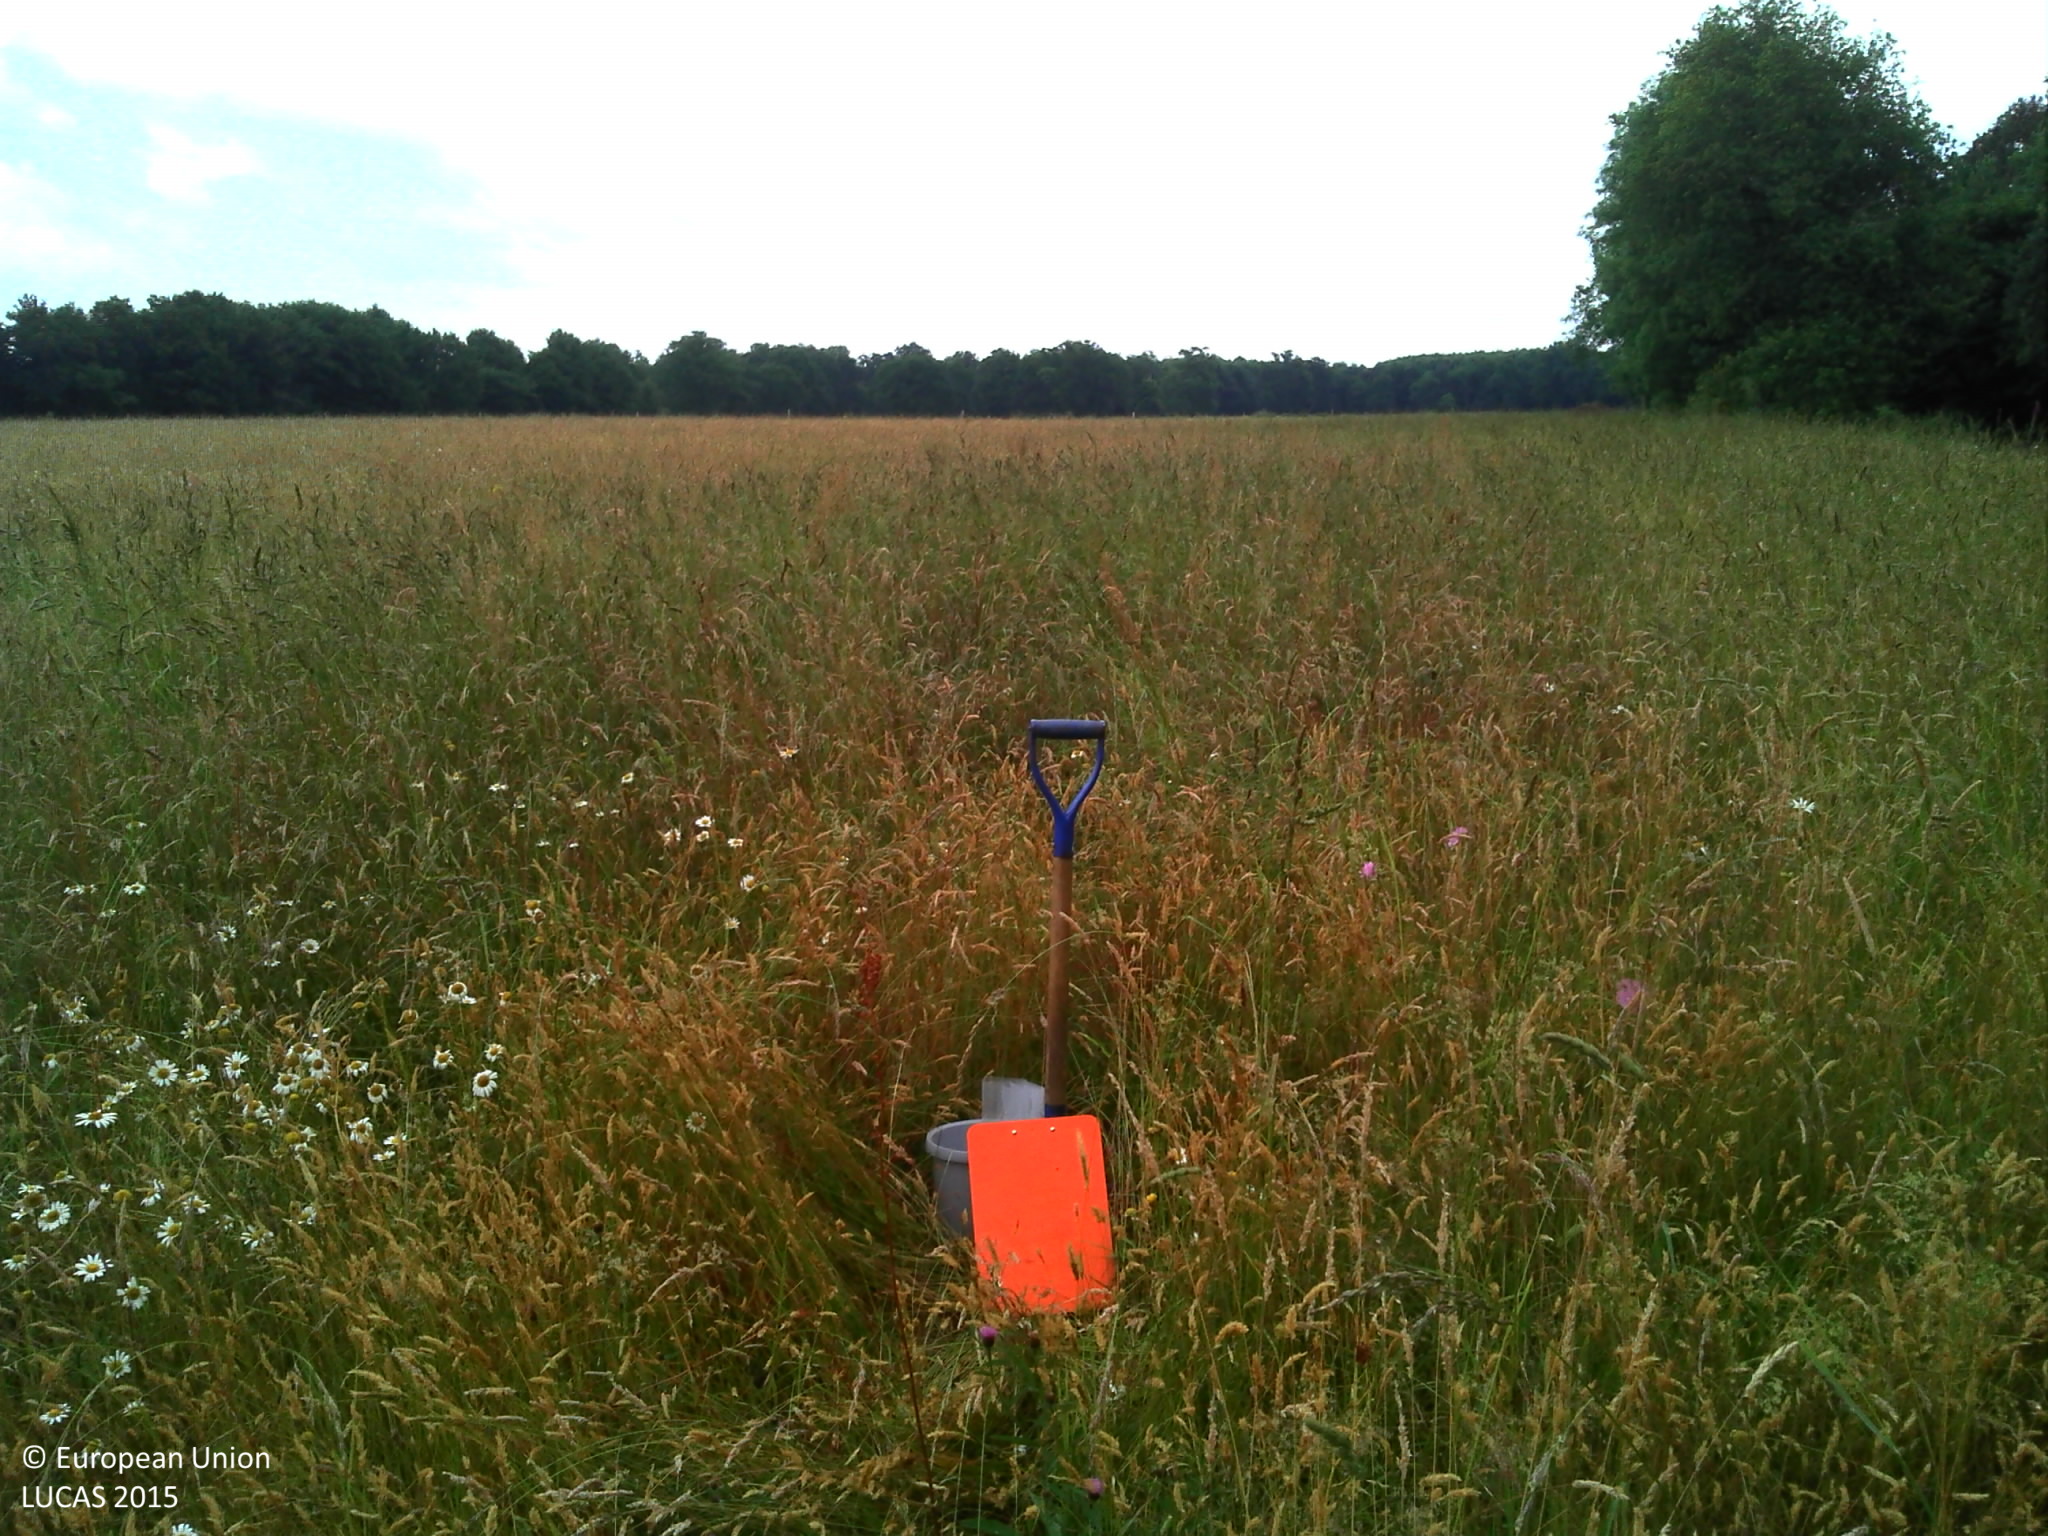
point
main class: Grassland
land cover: Grassland without tree/shrub cover
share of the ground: > 75 %
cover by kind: herbaceous plants 100 %
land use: Agriculture (excluding fallow land and kitchen gardens)
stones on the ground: < 10 %
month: June
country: FR
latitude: 45.9505
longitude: 0.5548
